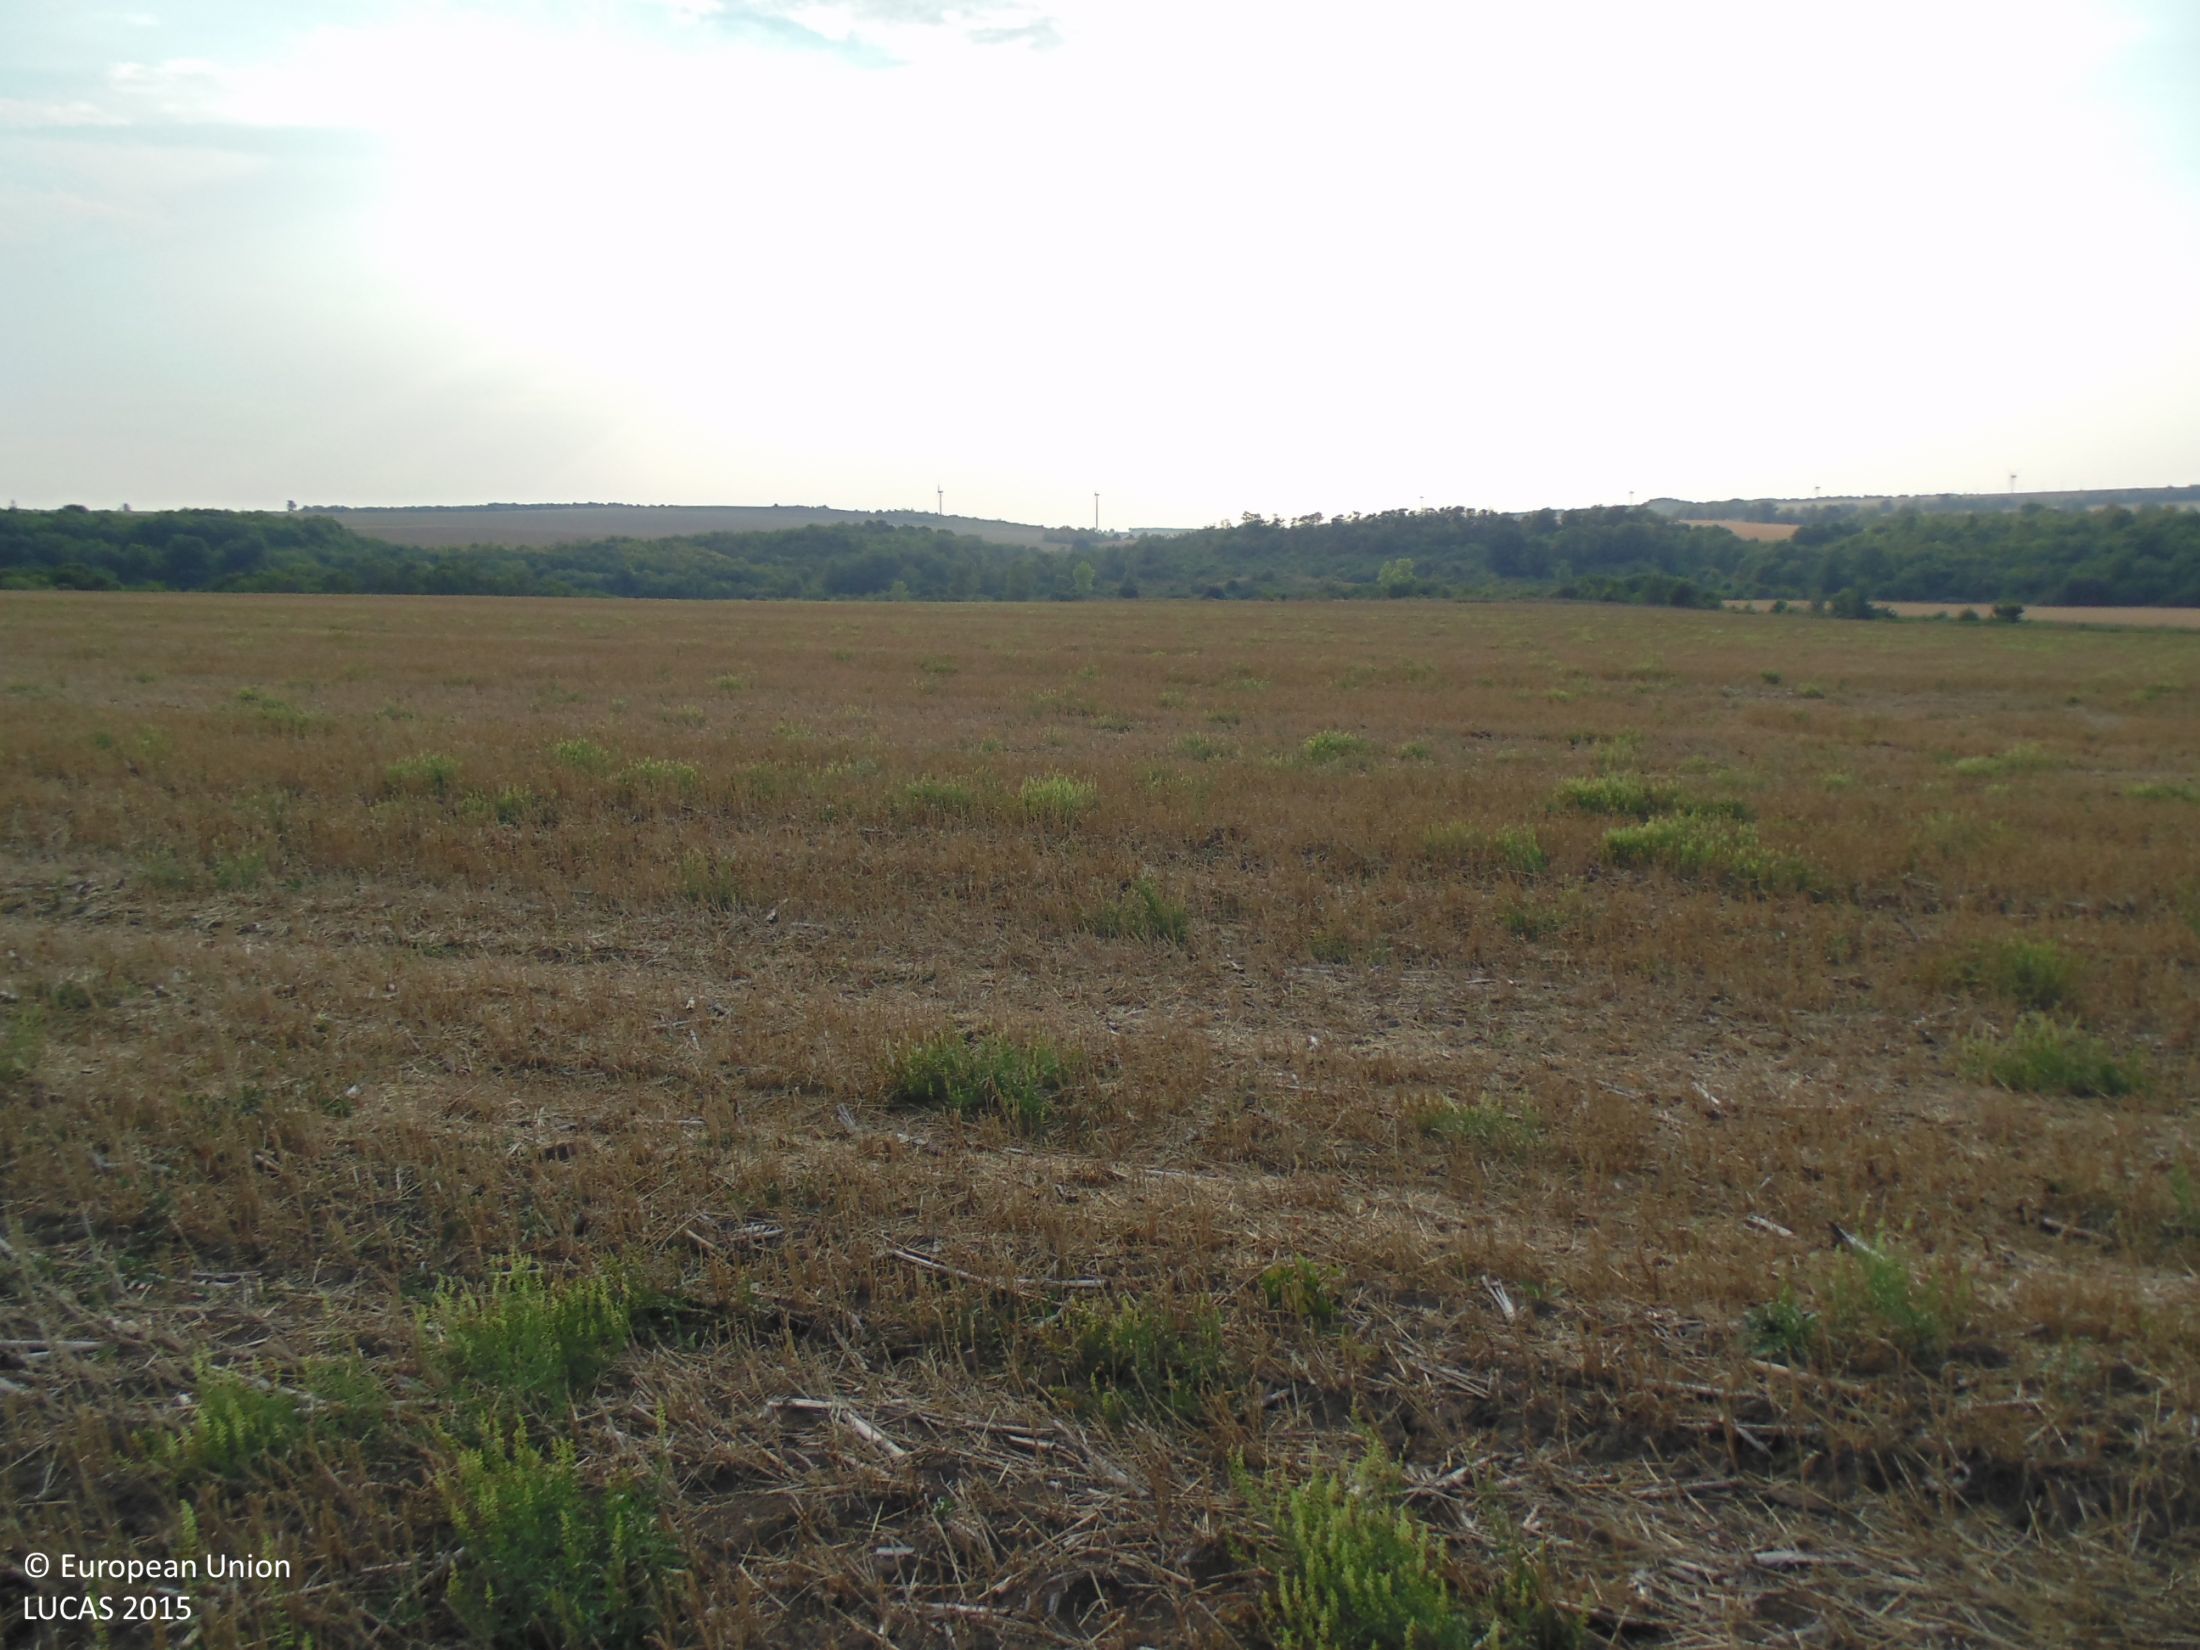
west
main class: Cropland
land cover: Common wheat
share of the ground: 25 - 50 %
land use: Agriculture (excluding fallow land and kitchen gardens)
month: August
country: BG
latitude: 43.6246
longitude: 27.5971
